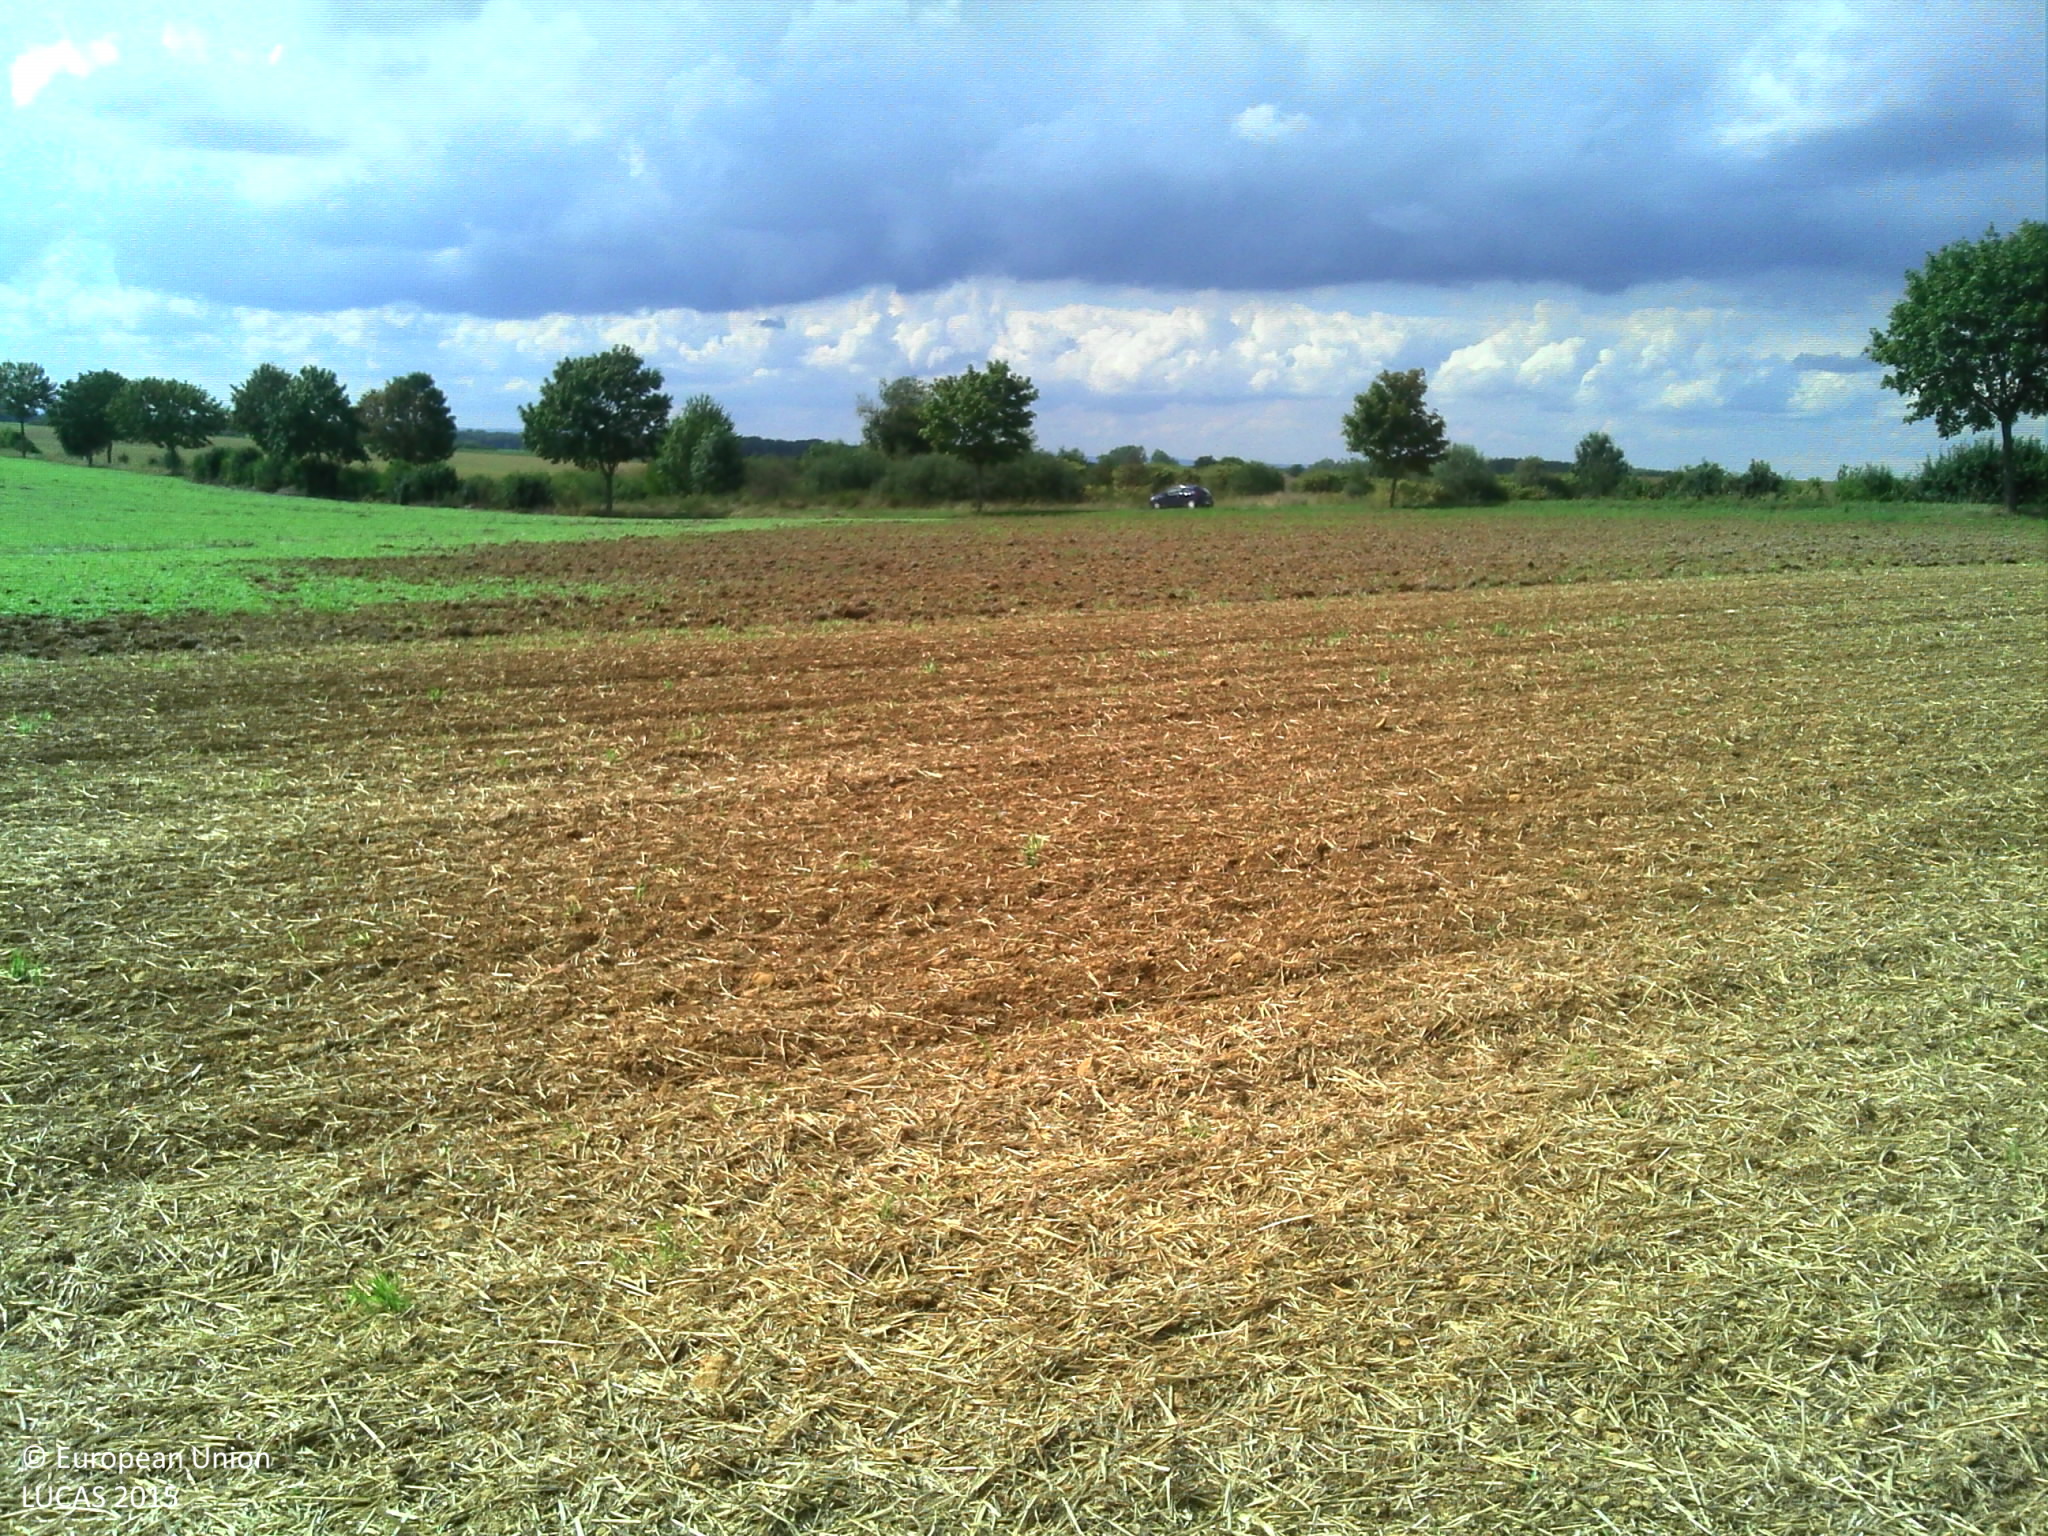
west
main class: Cropland
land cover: Common wheat
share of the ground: < 10 %
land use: Agriculture (excluding fallow land and kitchen gardens)
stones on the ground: 10 - 25 %
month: September
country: FR
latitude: 49.1392
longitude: 5.9284
